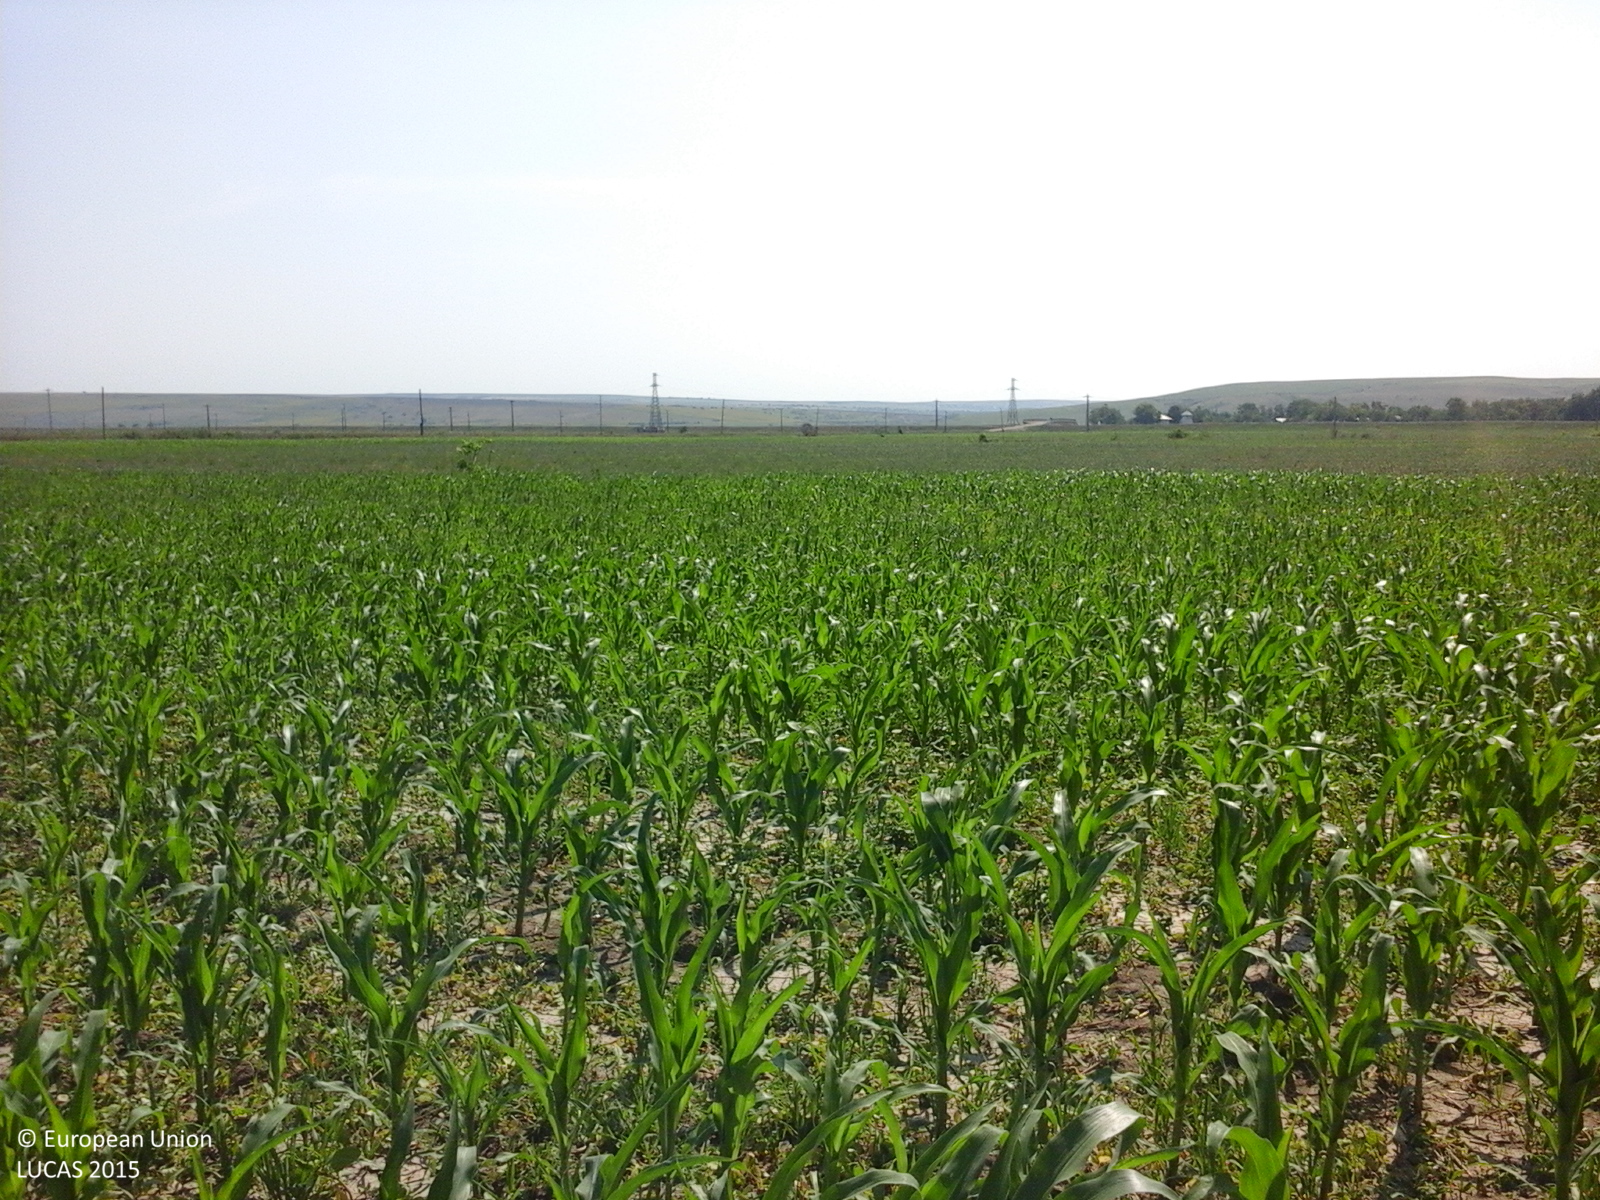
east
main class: Cropland
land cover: Maize
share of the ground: 50 - 75 %
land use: Agriculture (excluding fallow land and kitchen gardens)
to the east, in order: Maize
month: July
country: RO
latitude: 46.1168
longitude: 27.5652
